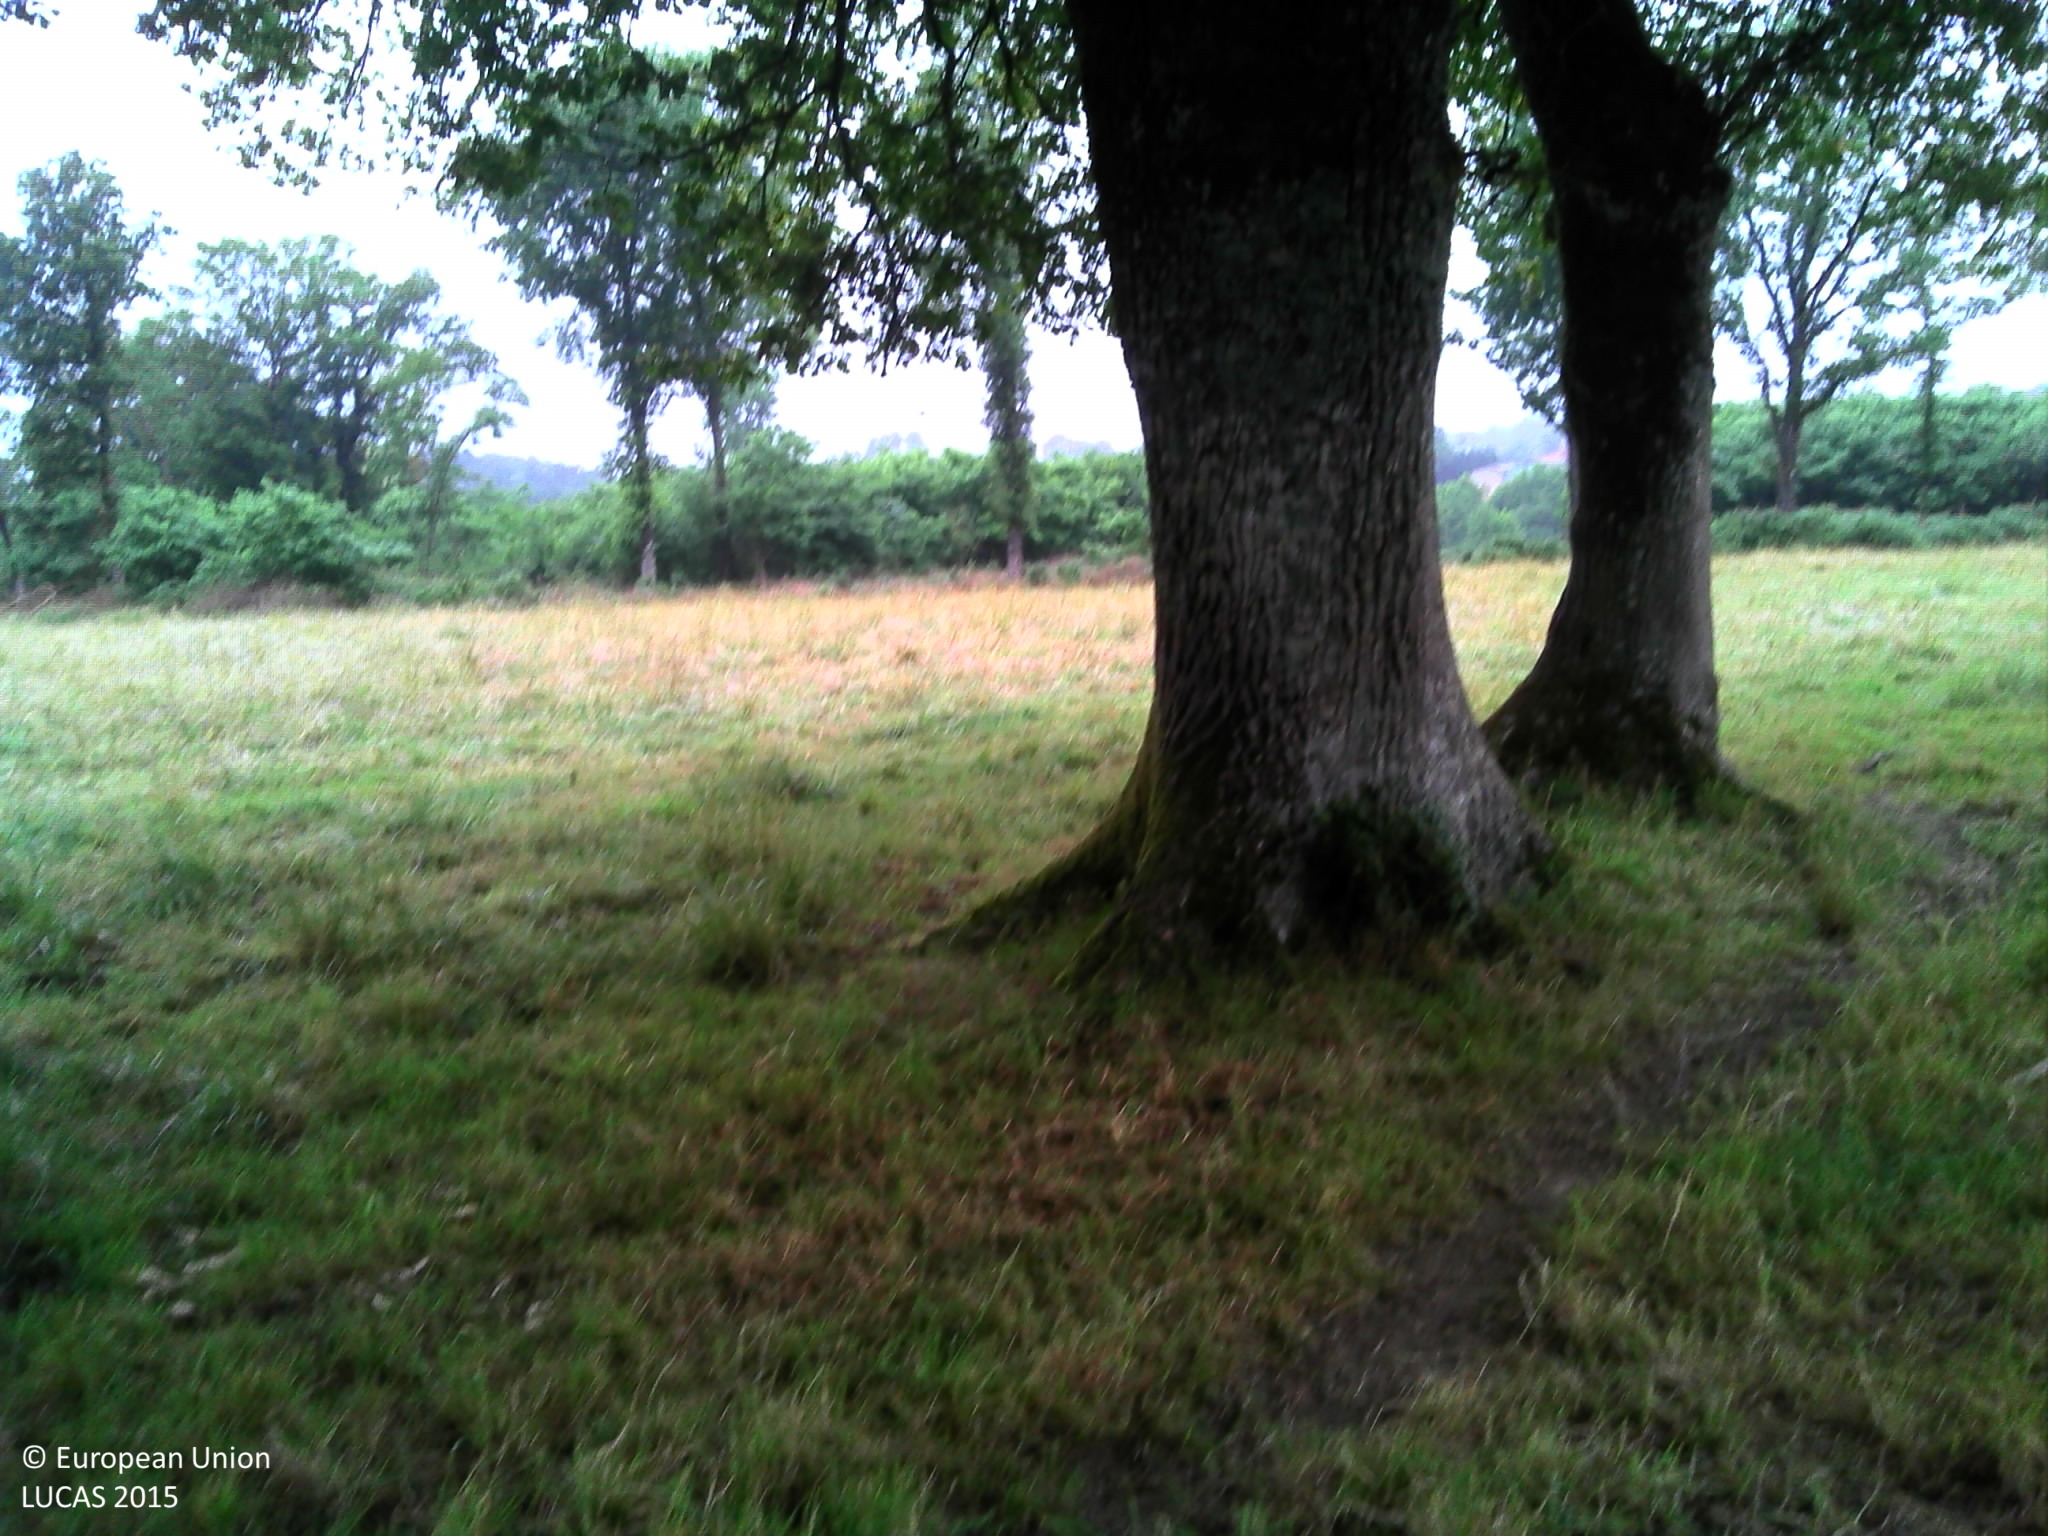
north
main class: Grassland
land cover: Grassland with sparse tree/shrub cover
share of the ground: > 75 %
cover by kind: herbaceous plants 95 %, coniferous forest trees 5 %
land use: Agriculture (excluding fallow land and kitchen gardens)
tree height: > 5 m
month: June
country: FR
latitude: 45.7899
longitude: 0.5828
